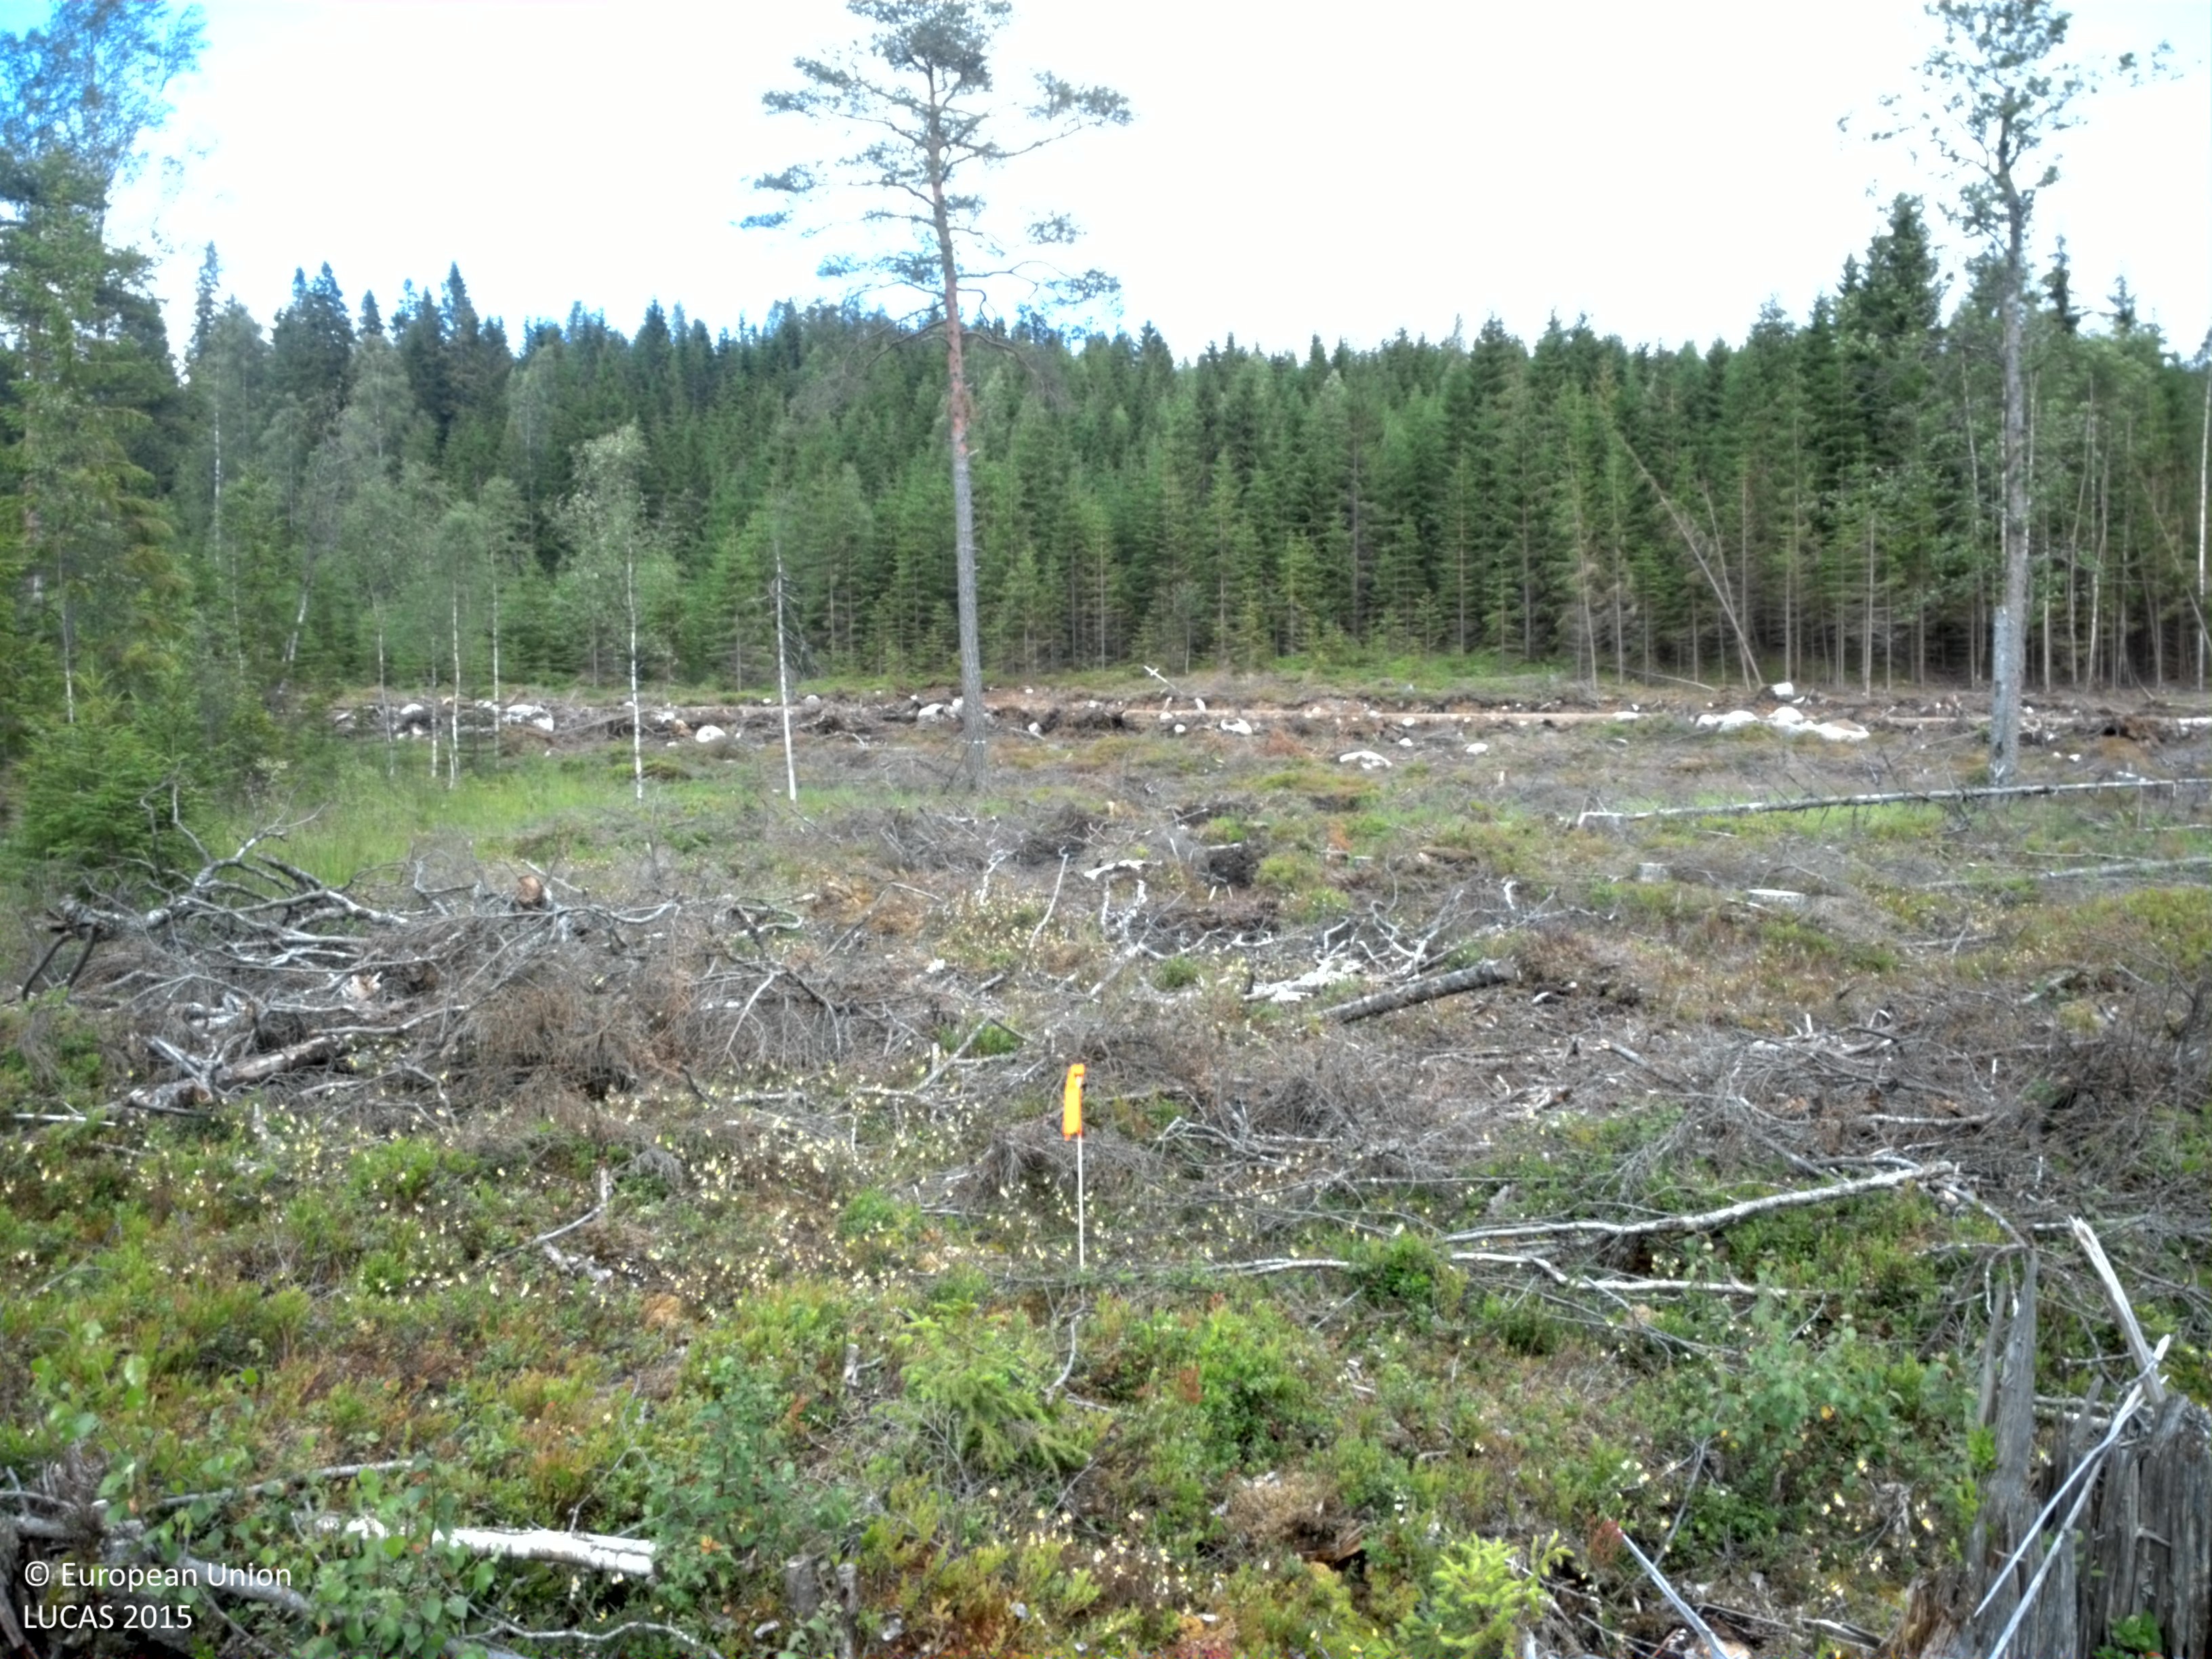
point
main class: Woodland
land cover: Broadleaved woodland
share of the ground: 10 - 25 %
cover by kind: shrubs 55 %, herbaceous plants 20 %, broadleaved forest trees 15 %, unconsolidated bare surface 10 %
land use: Forestry
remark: Clear cut
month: July
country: SE
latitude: 59.7508
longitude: 14.4217
